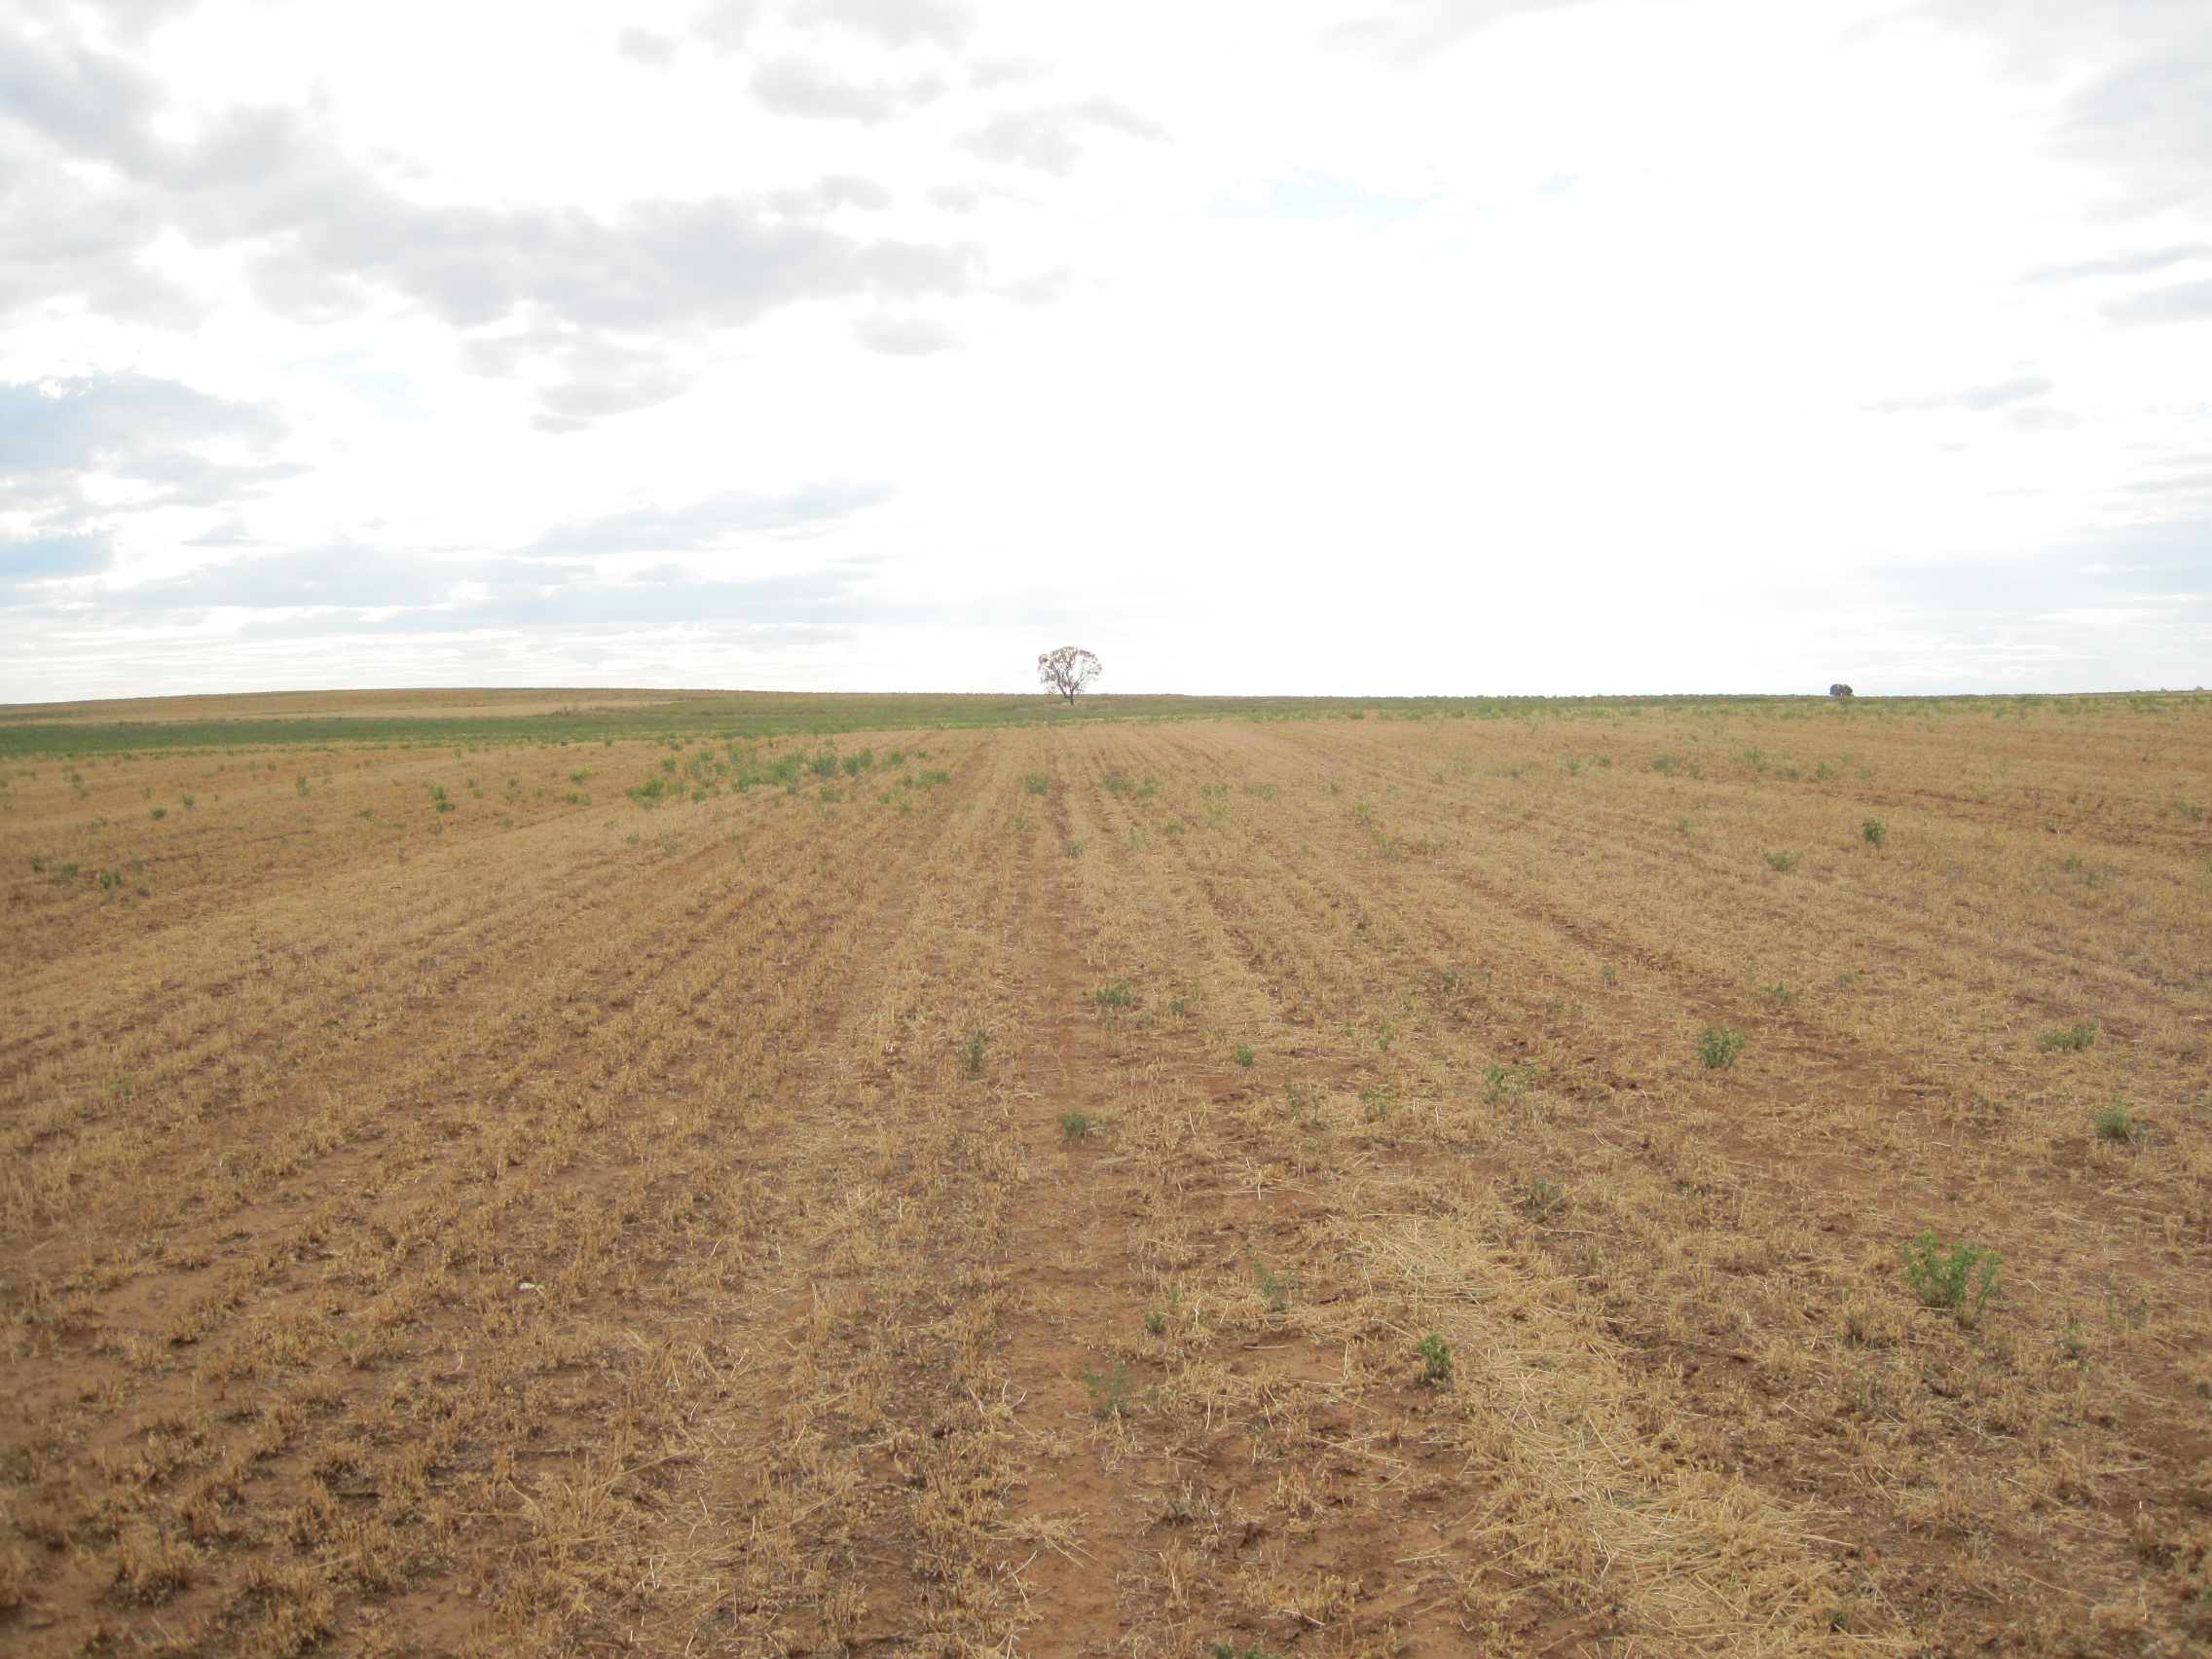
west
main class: Cropland
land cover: Lucerne
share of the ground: < 10 %
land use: Agriculture (excluding fallow land and kitchen gardens)
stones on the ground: 10 - 25 %
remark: Harvested field
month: July
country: ES
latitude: 41.9390
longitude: -5.4402
